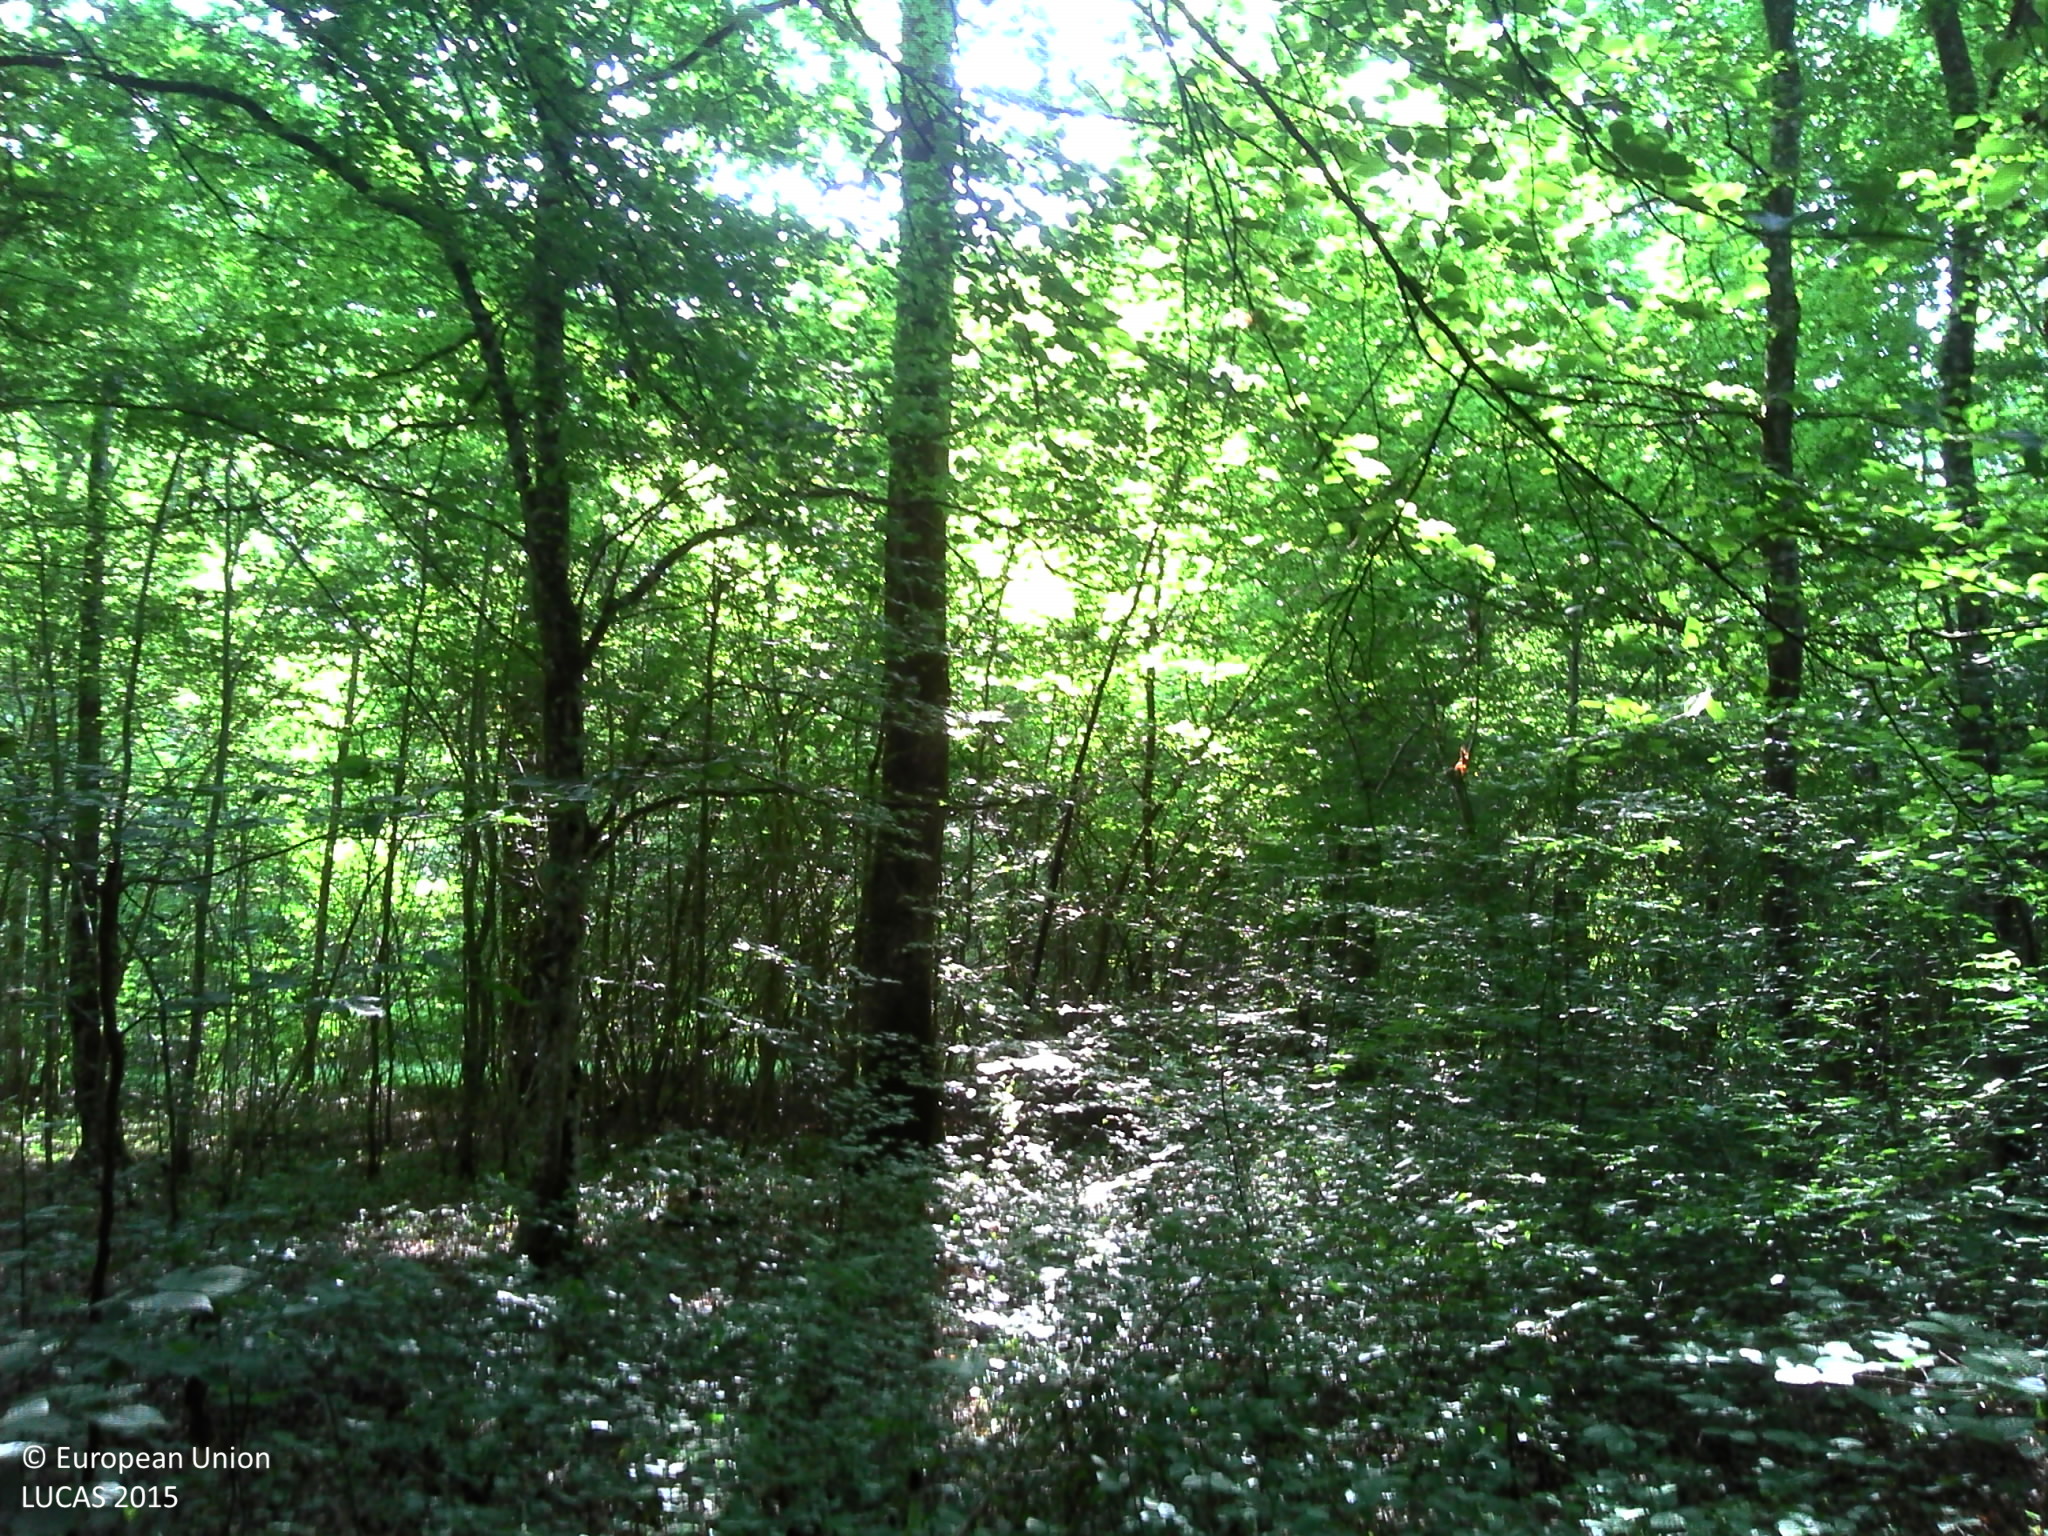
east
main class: Woodland
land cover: Broadleaved woodland
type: mesophytic deciduous forest
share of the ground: > 75 %
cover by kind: broadleaved forest trees 80 %, shrubs 10 %, herbaceous plants 10 %
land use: Forestry
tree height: > 5 m
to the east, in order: Broadleaved woodland; Ditches and canals; Tracks; Ditches and canals; Broadleaved woodland; Tracks
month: June
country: FR
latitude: 47.1562
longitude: 5.4510
